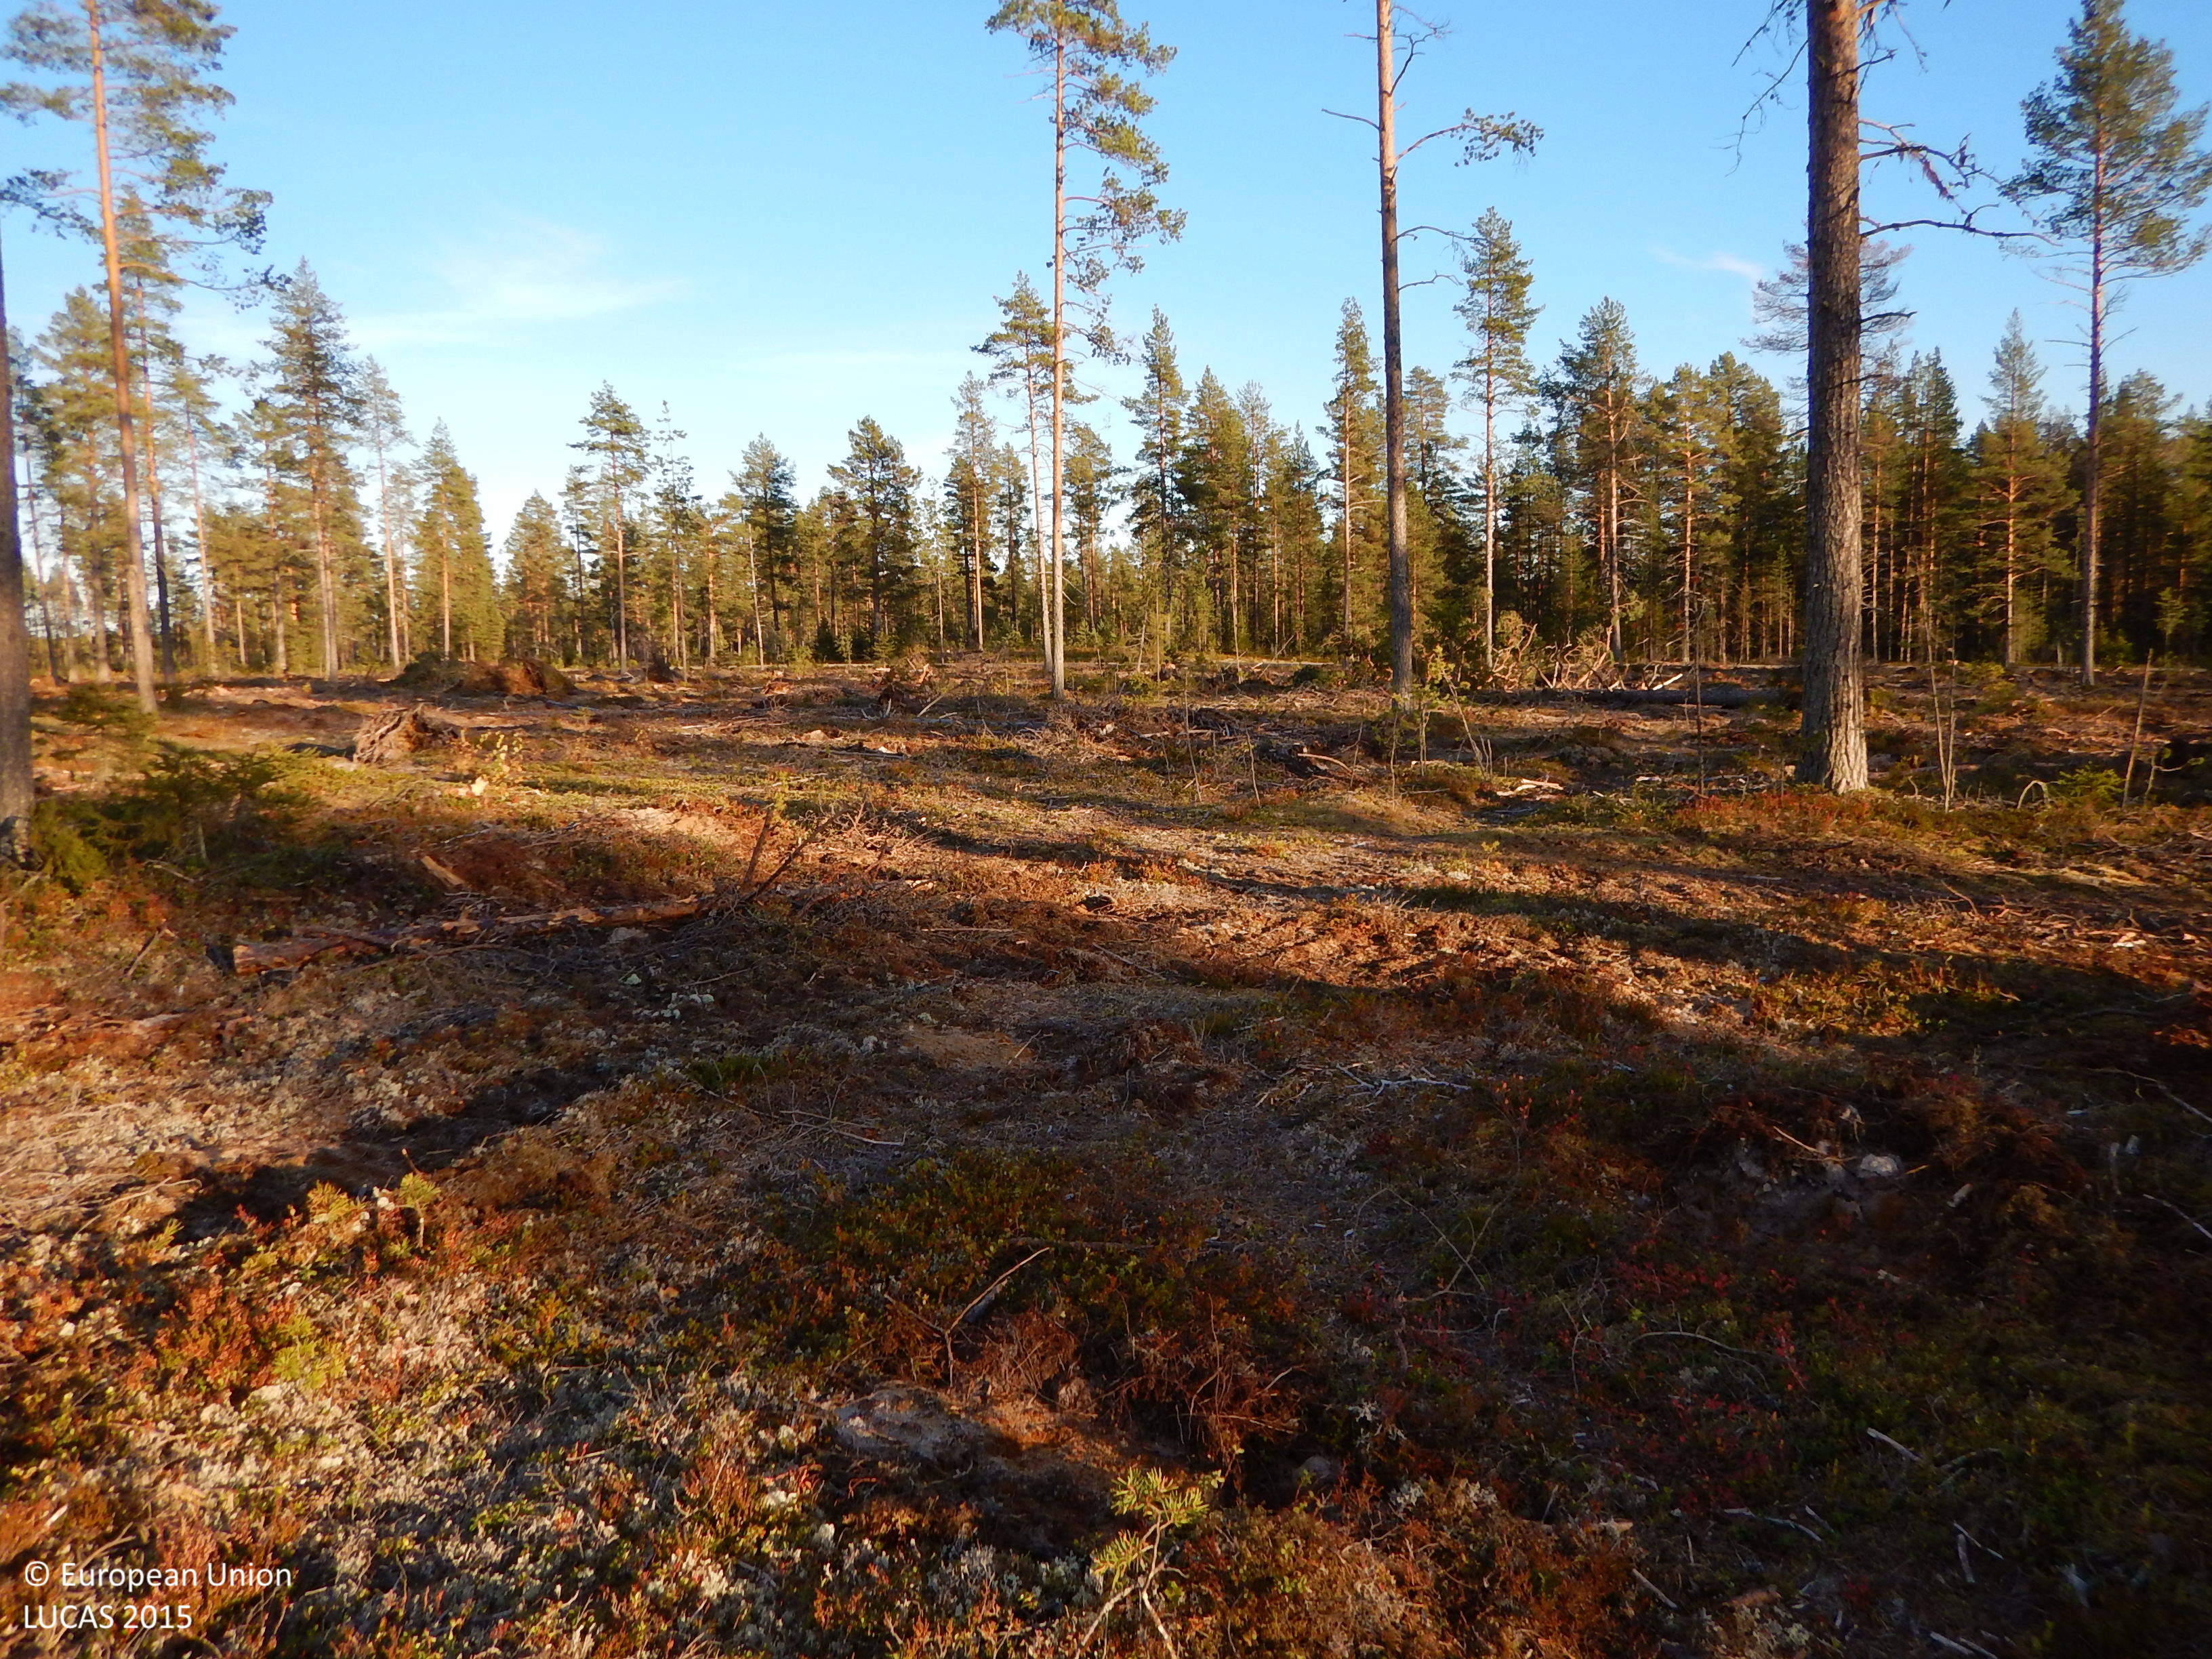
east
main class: Woodland
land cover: Pine dominated coniferous woodland
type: boreal forest
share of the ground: 10 - 25 %
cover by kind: shrubs 40 %, lichens and mosses 30 %, herbaceous plants 20 %, coniferous forest trees 10 %
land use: Forestry
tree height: > 5 m
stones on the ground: < 10 %
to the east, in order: Pine dominated coniferous woodland; Paved roads, cycling and walking lanes; Pine dominated coniferous woodland
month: October
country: SE
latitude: 65.1059
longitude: 20.8103
